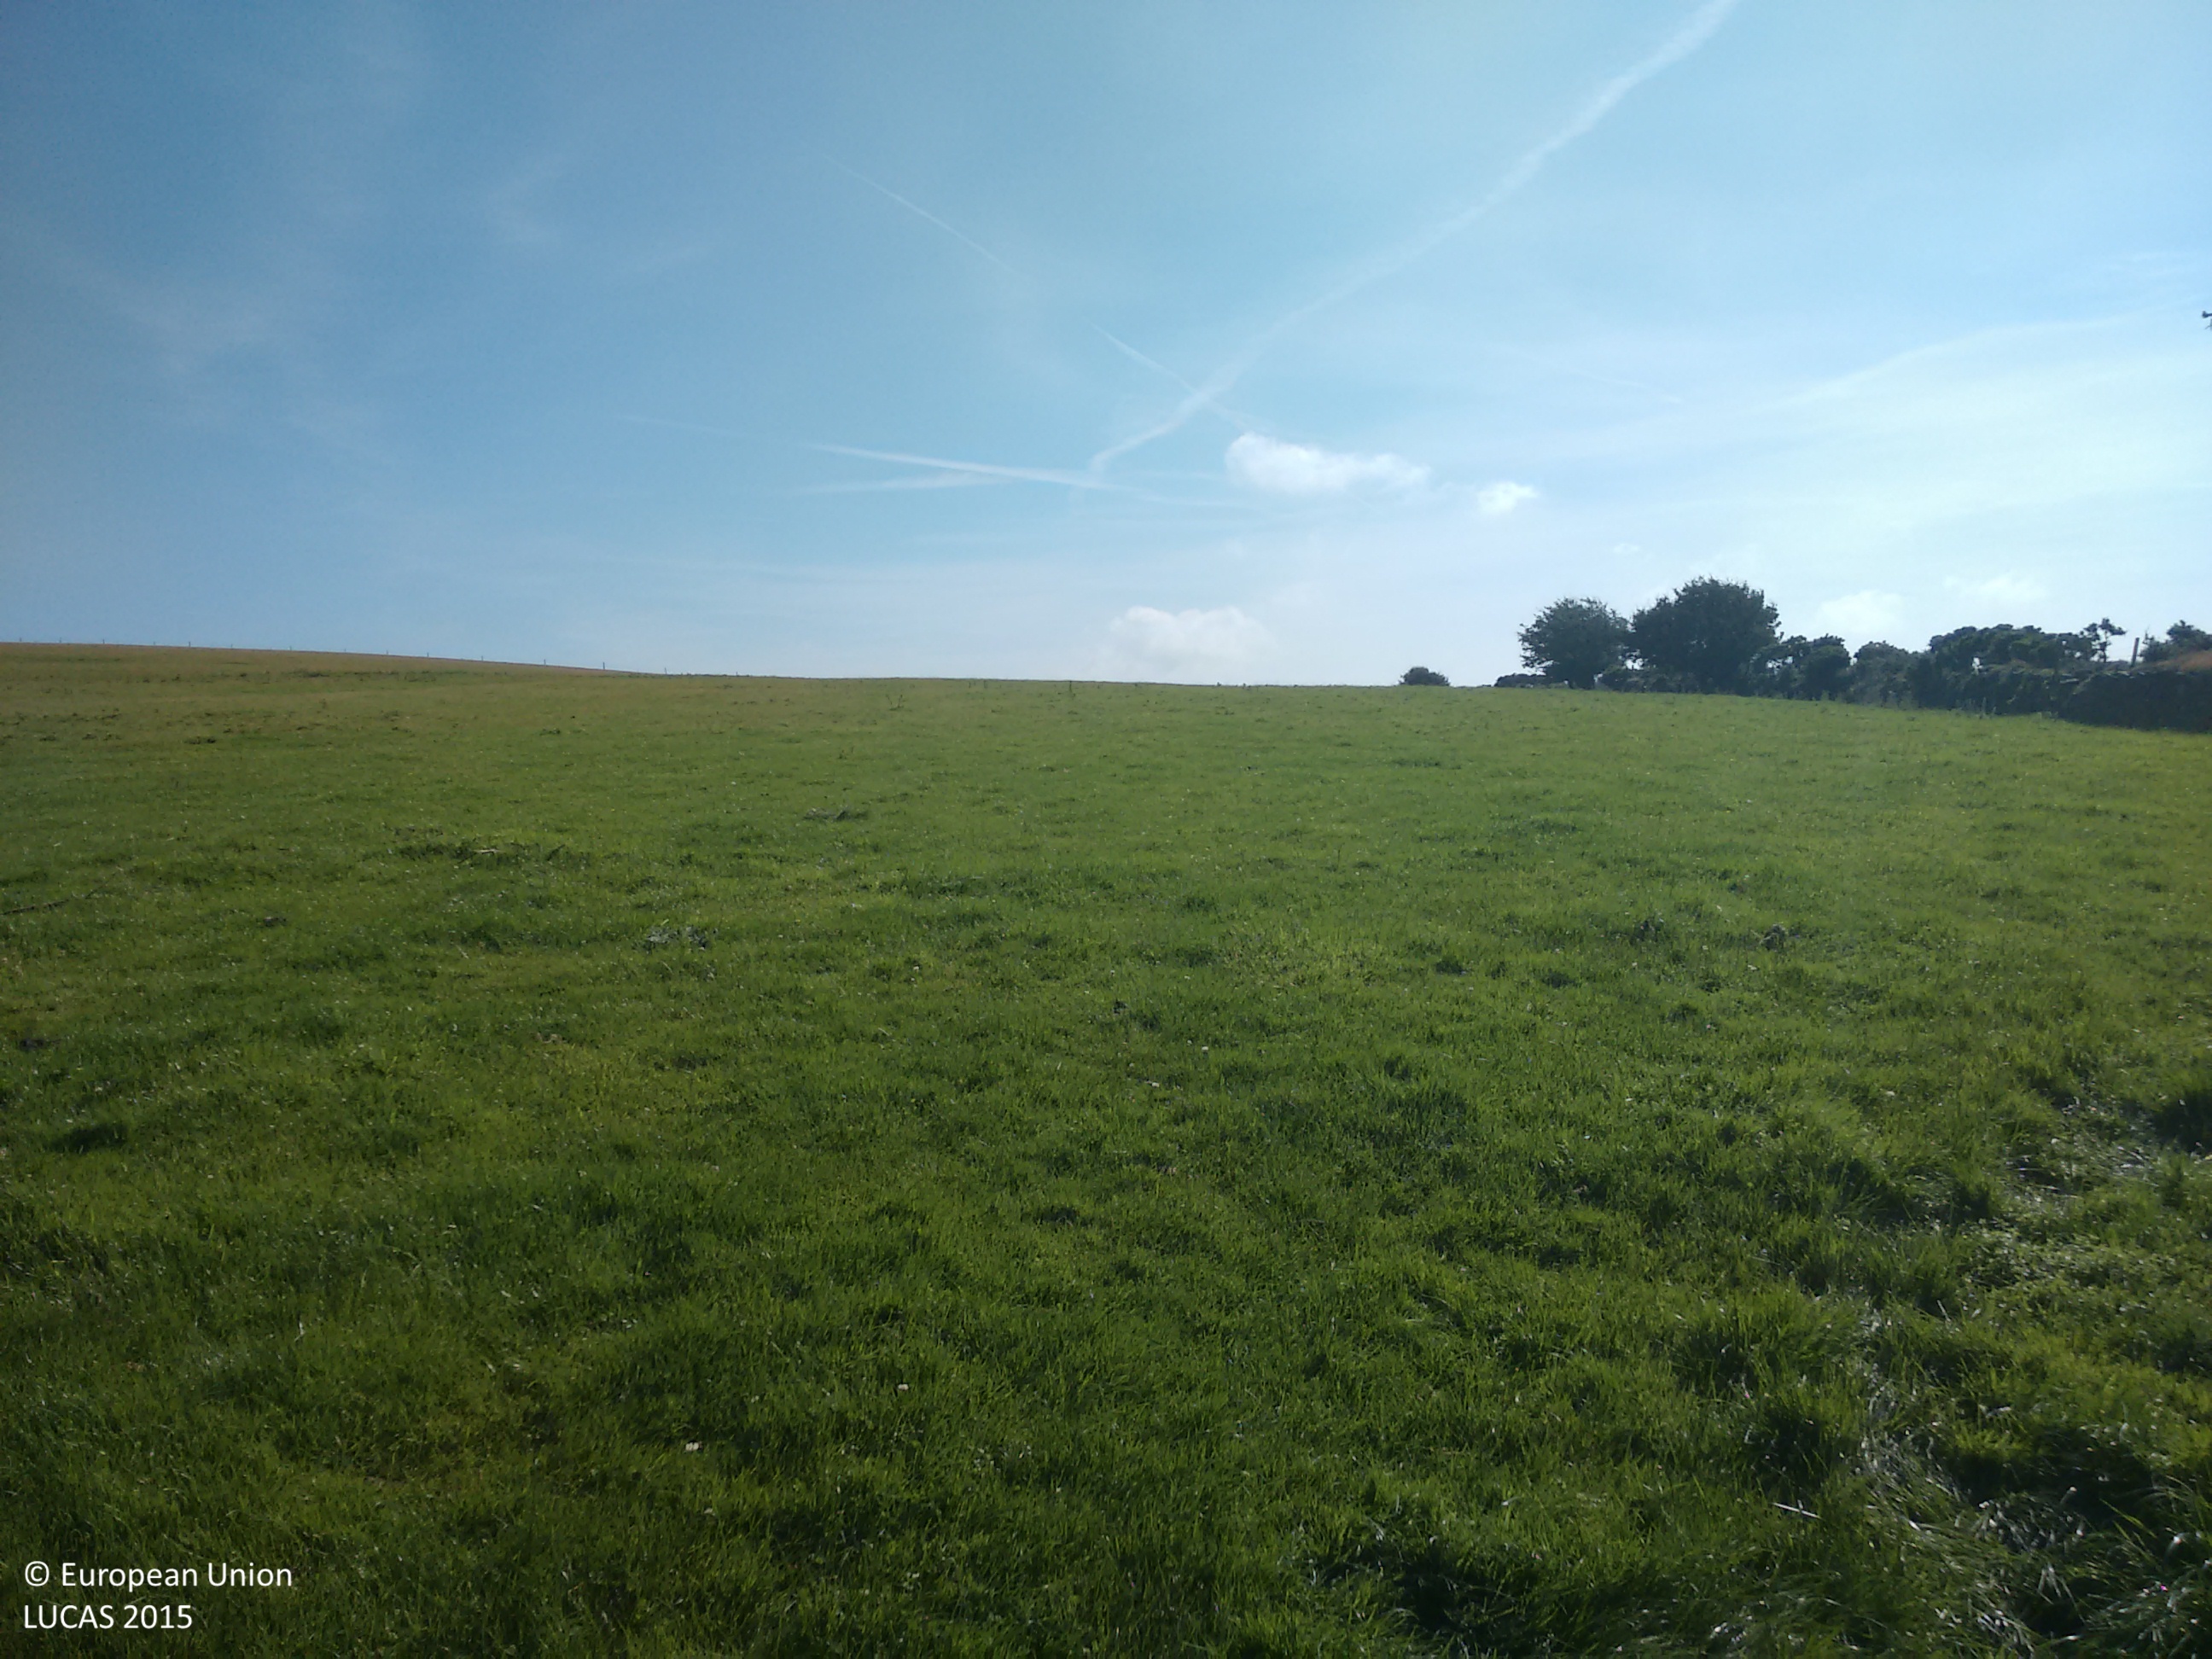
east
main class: Grassland
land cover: Grassland without tree/shrub cover
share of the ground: > 75 %
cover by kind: herbaceous plants 100 %
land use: Agriculture (excluding fallow land and kitchen gardens)
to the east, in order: Grassland without tree/shrub cover; Fences; Managed hedges; Grassland without tree/shrub cover
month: August
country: GB
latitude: 51.2069
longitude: -3.9051
